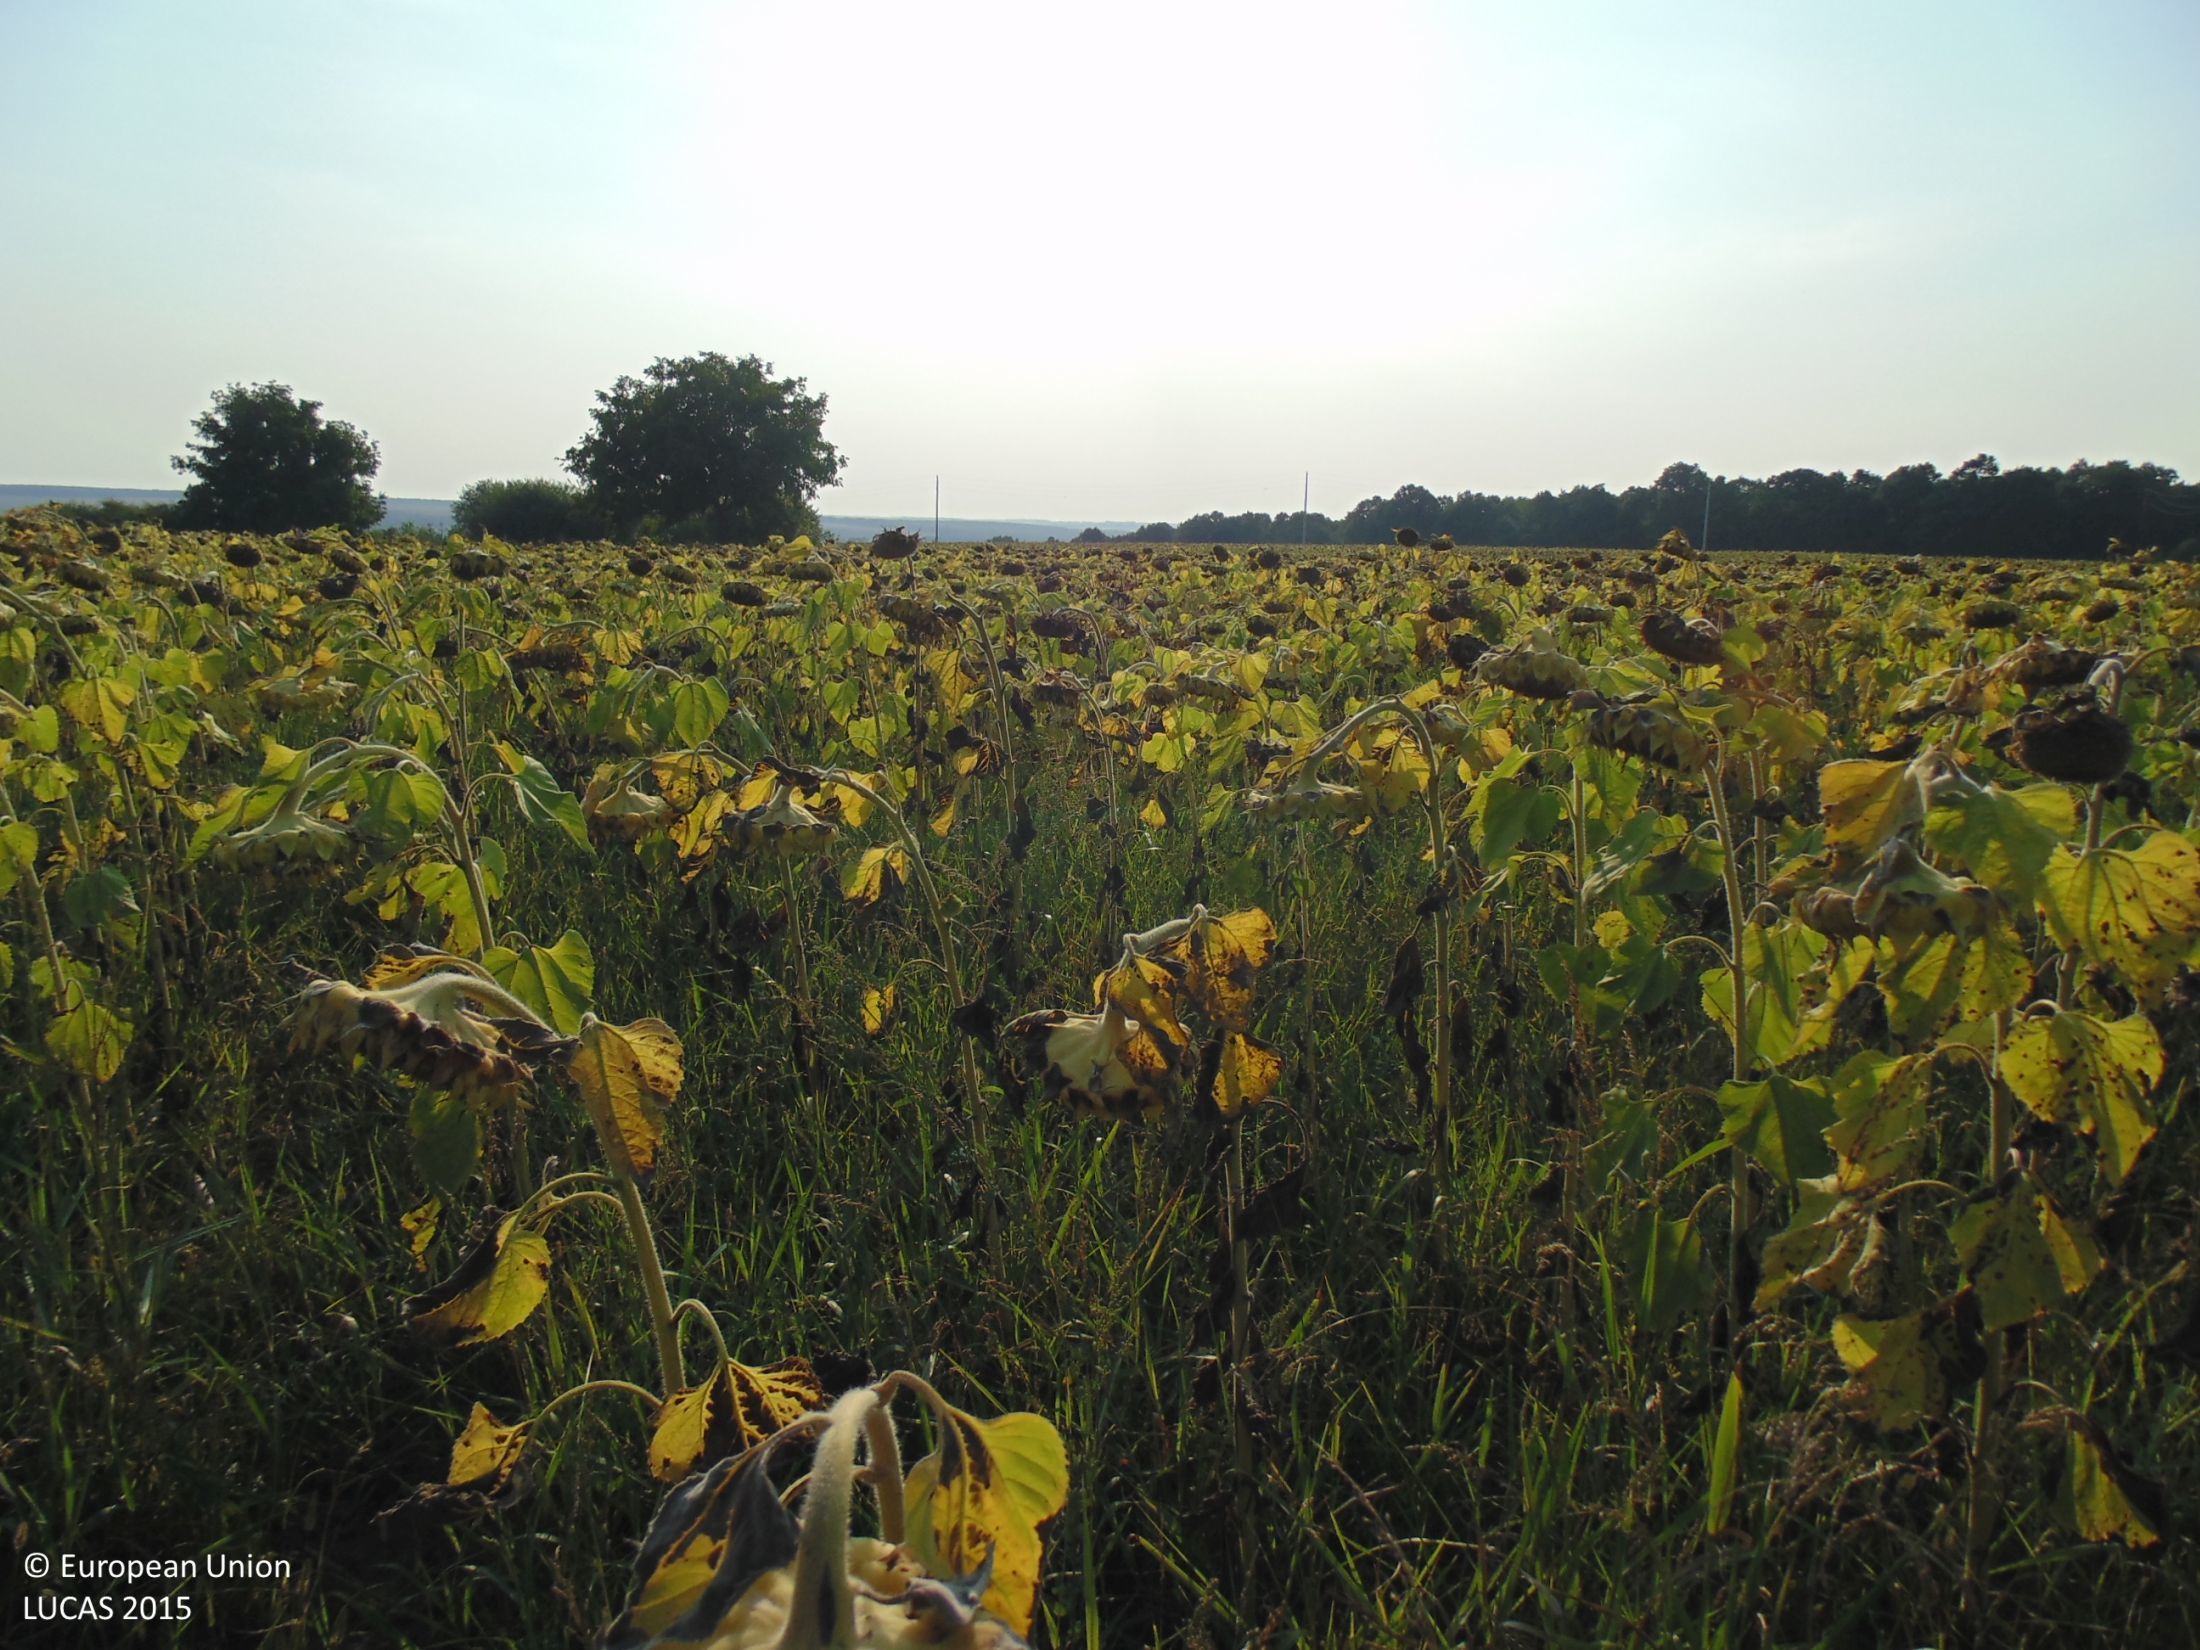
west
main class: Cropland
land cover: Sunflower
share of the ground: > 75 %
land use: Agriculture (excluding fallow land and kitchen gardens)
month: August
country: BG
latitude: 43.8538
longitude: 27.3358
